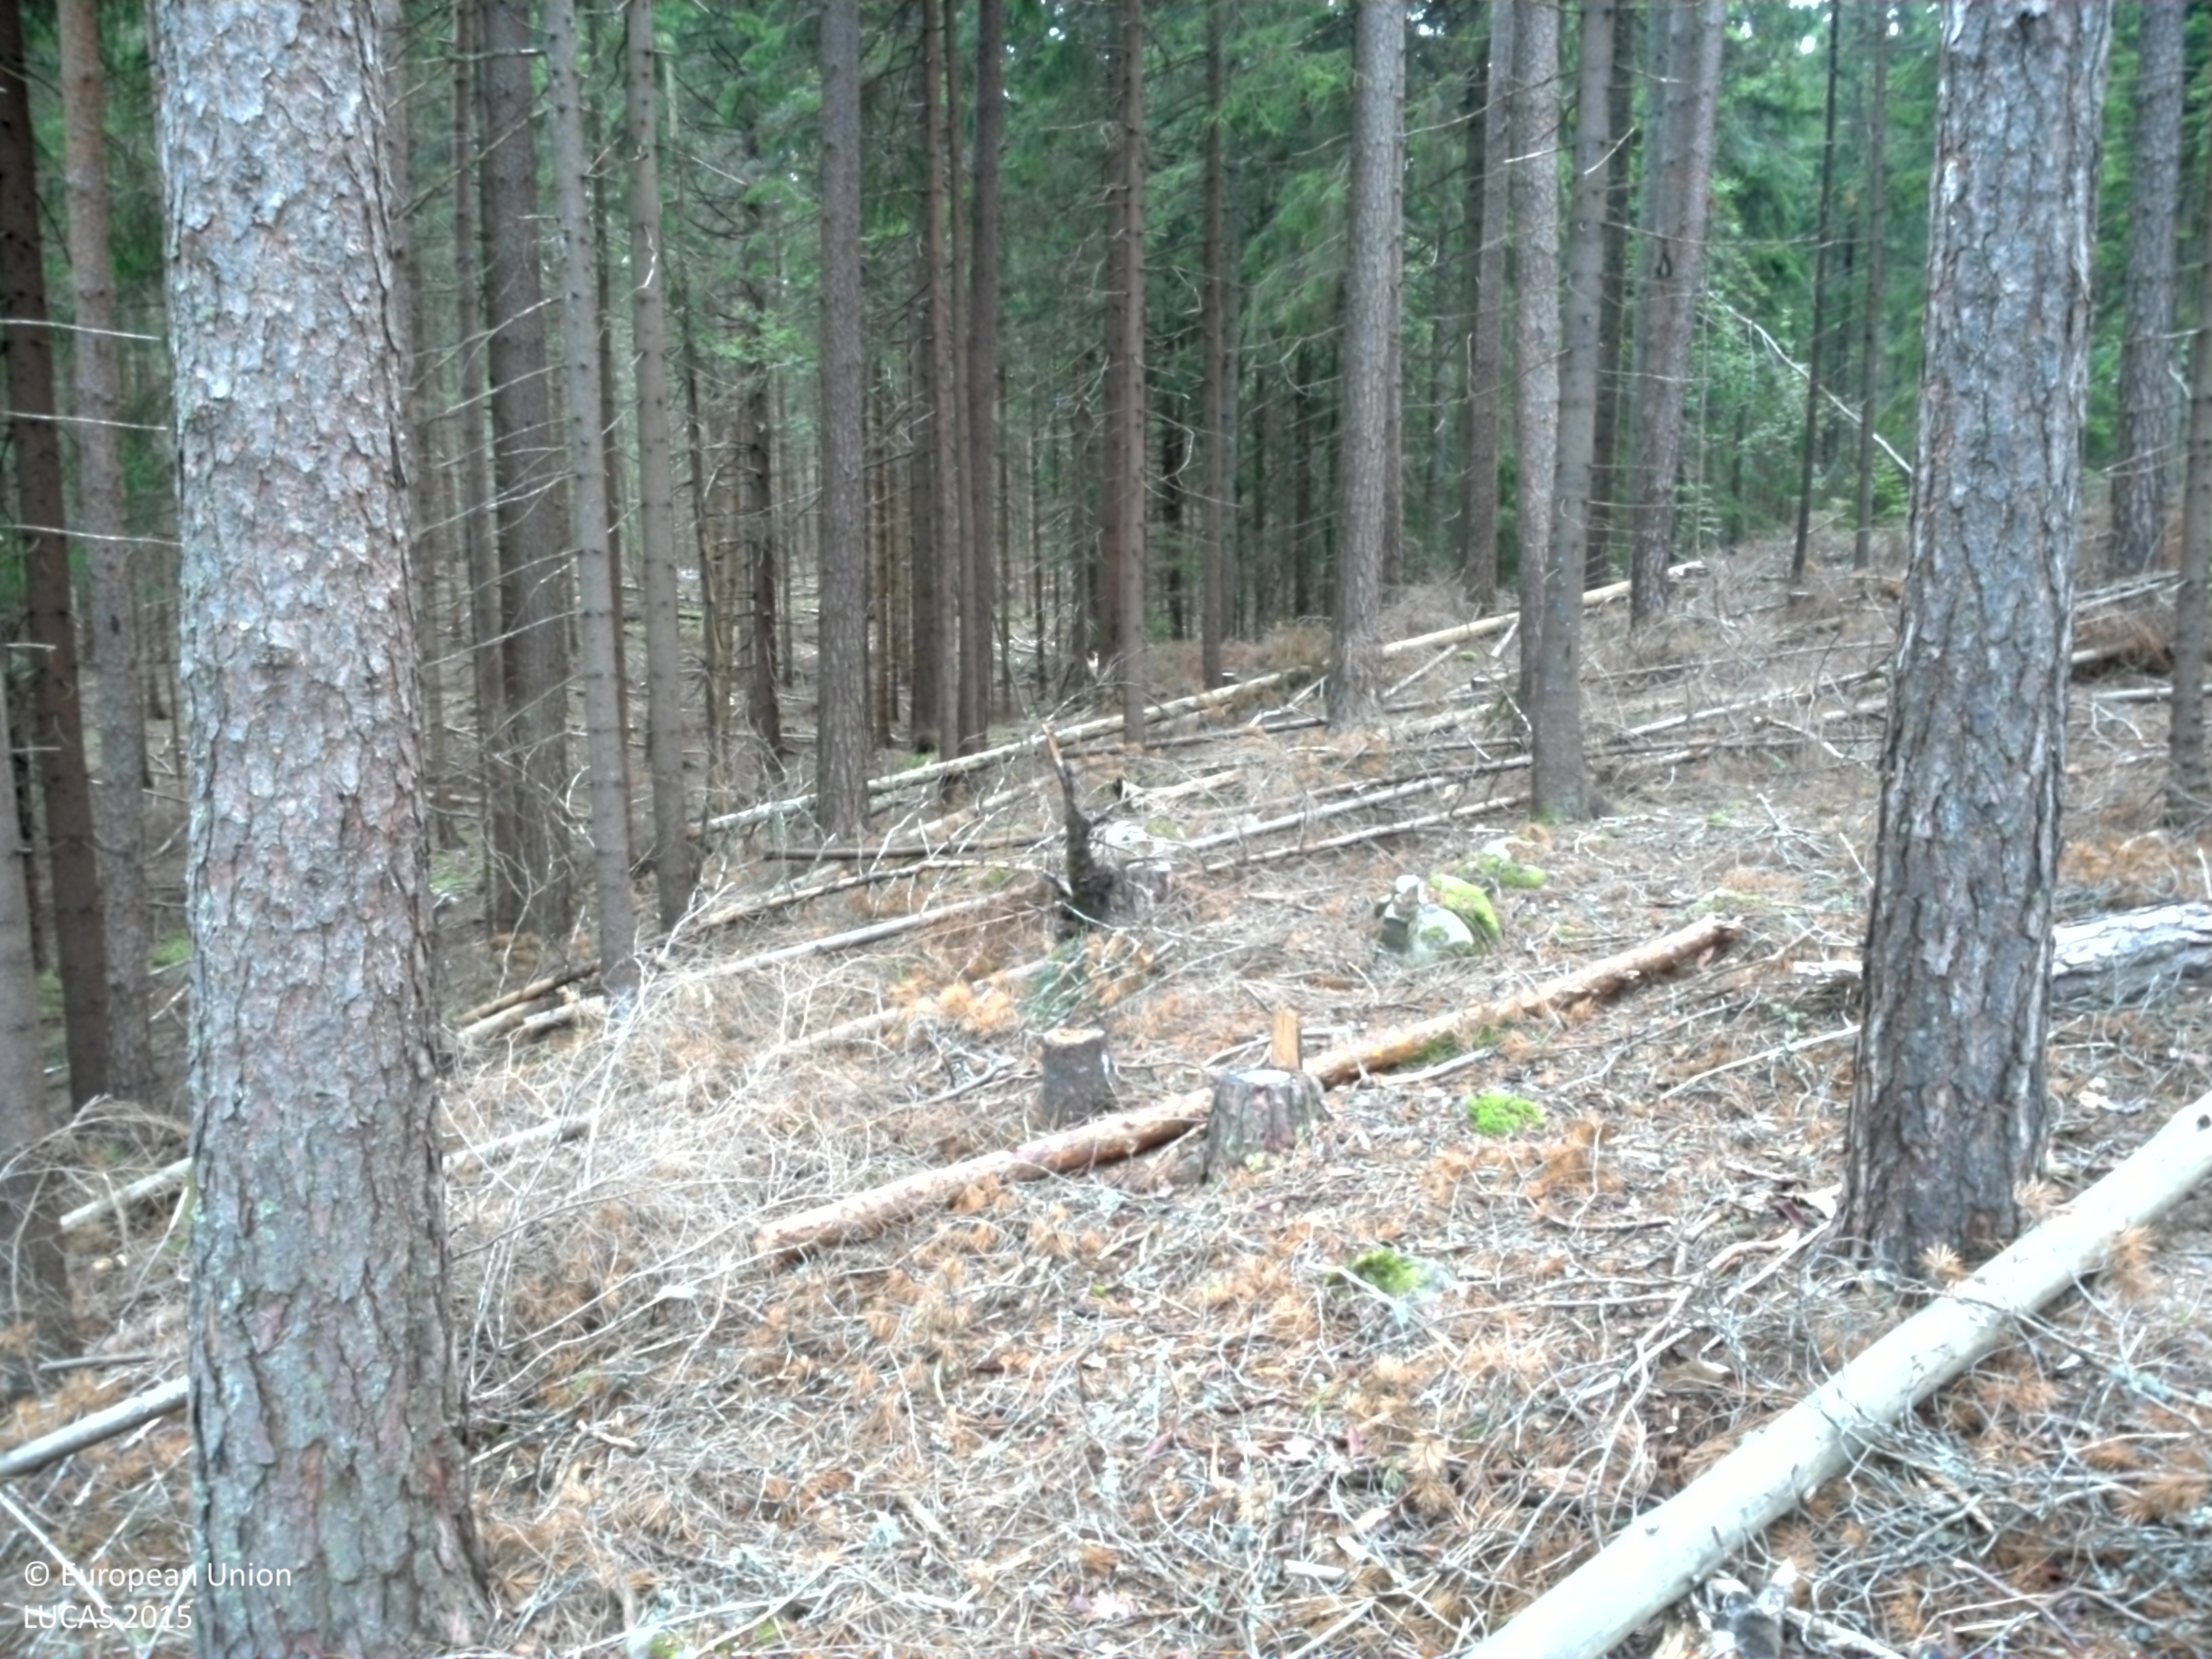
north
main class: Woodland
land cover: Pine dominated coniferous woodland
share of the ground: 50 - 75 %
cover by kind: coniferous forest trees 50 %, unconsolidated bare surface 35 %, herbaceous plants 15 %
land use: Forestry
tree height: > 5 m
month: July
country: SE
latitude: 57.7294
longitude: 14.5124
